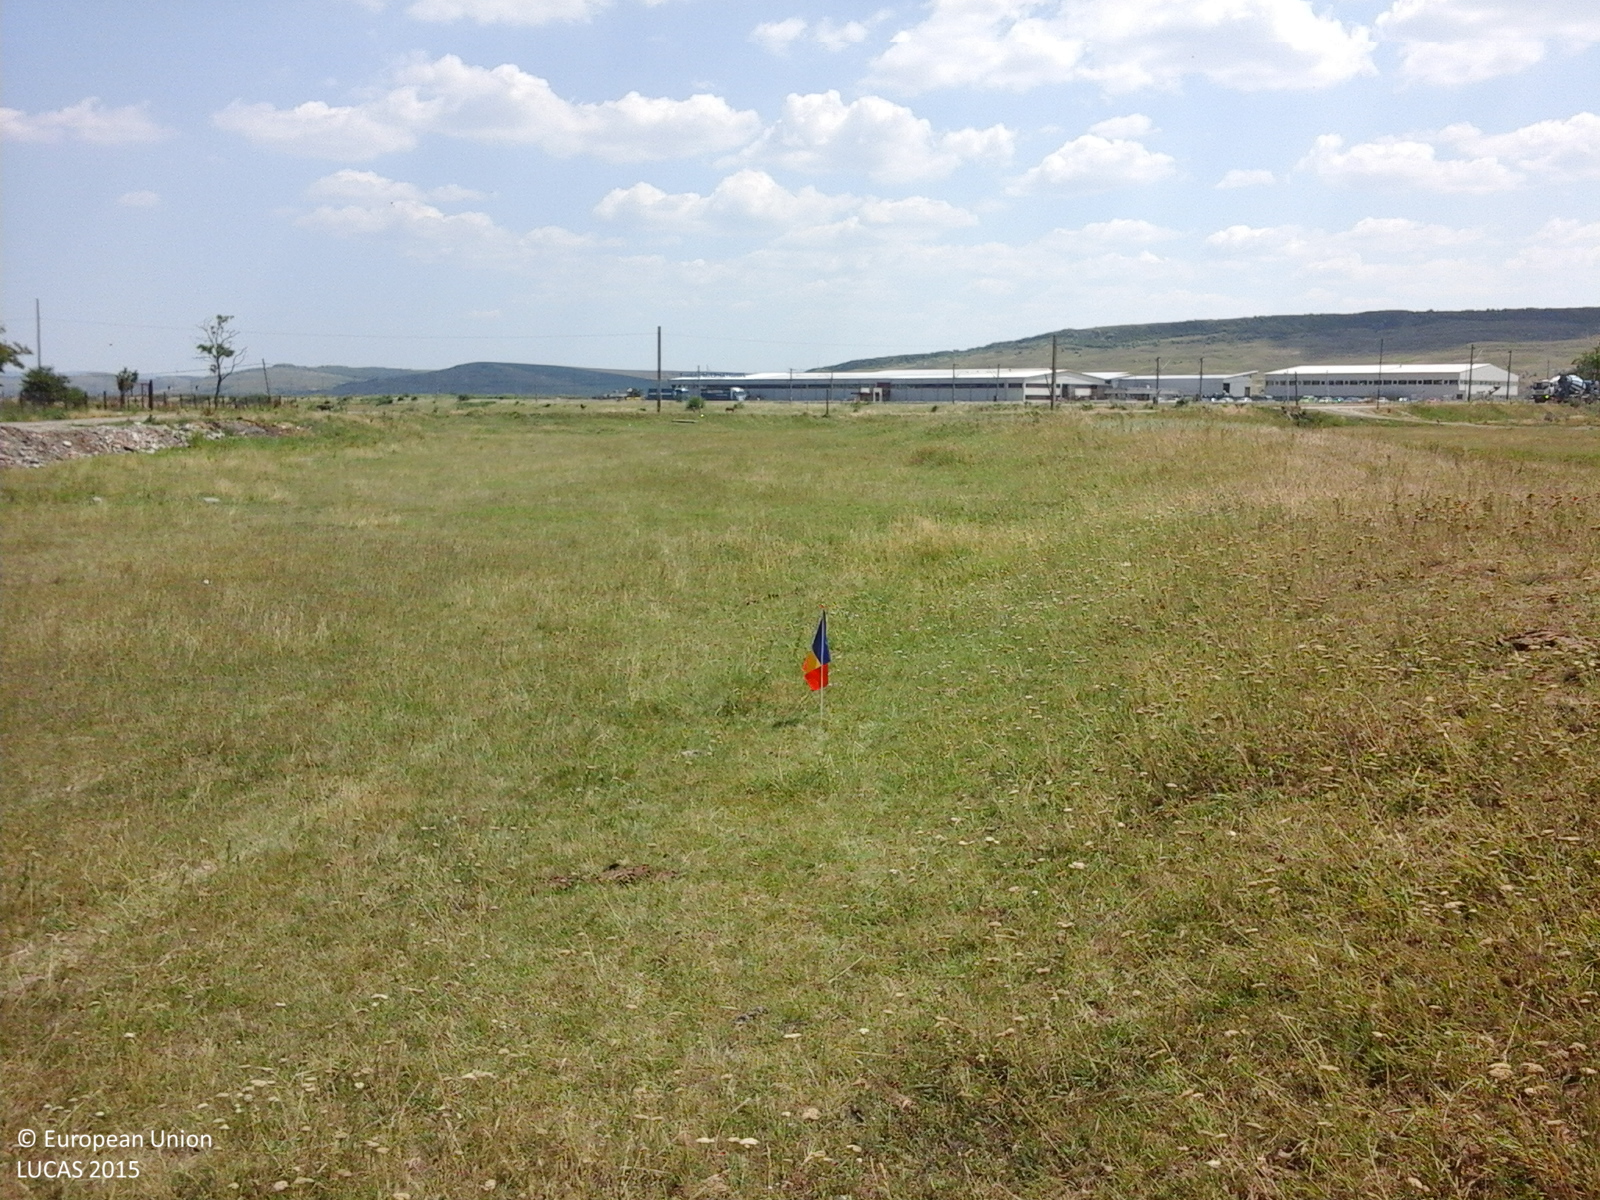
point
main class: Grassland
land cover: Grassland without tree/shrub cover
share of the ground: > 75 %
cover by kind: herbaceous plants 100 %
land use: Agriculture (excluding fallow land and kitchen gardens)
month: June
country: RO
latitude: 47.1908
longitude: 27.4162
